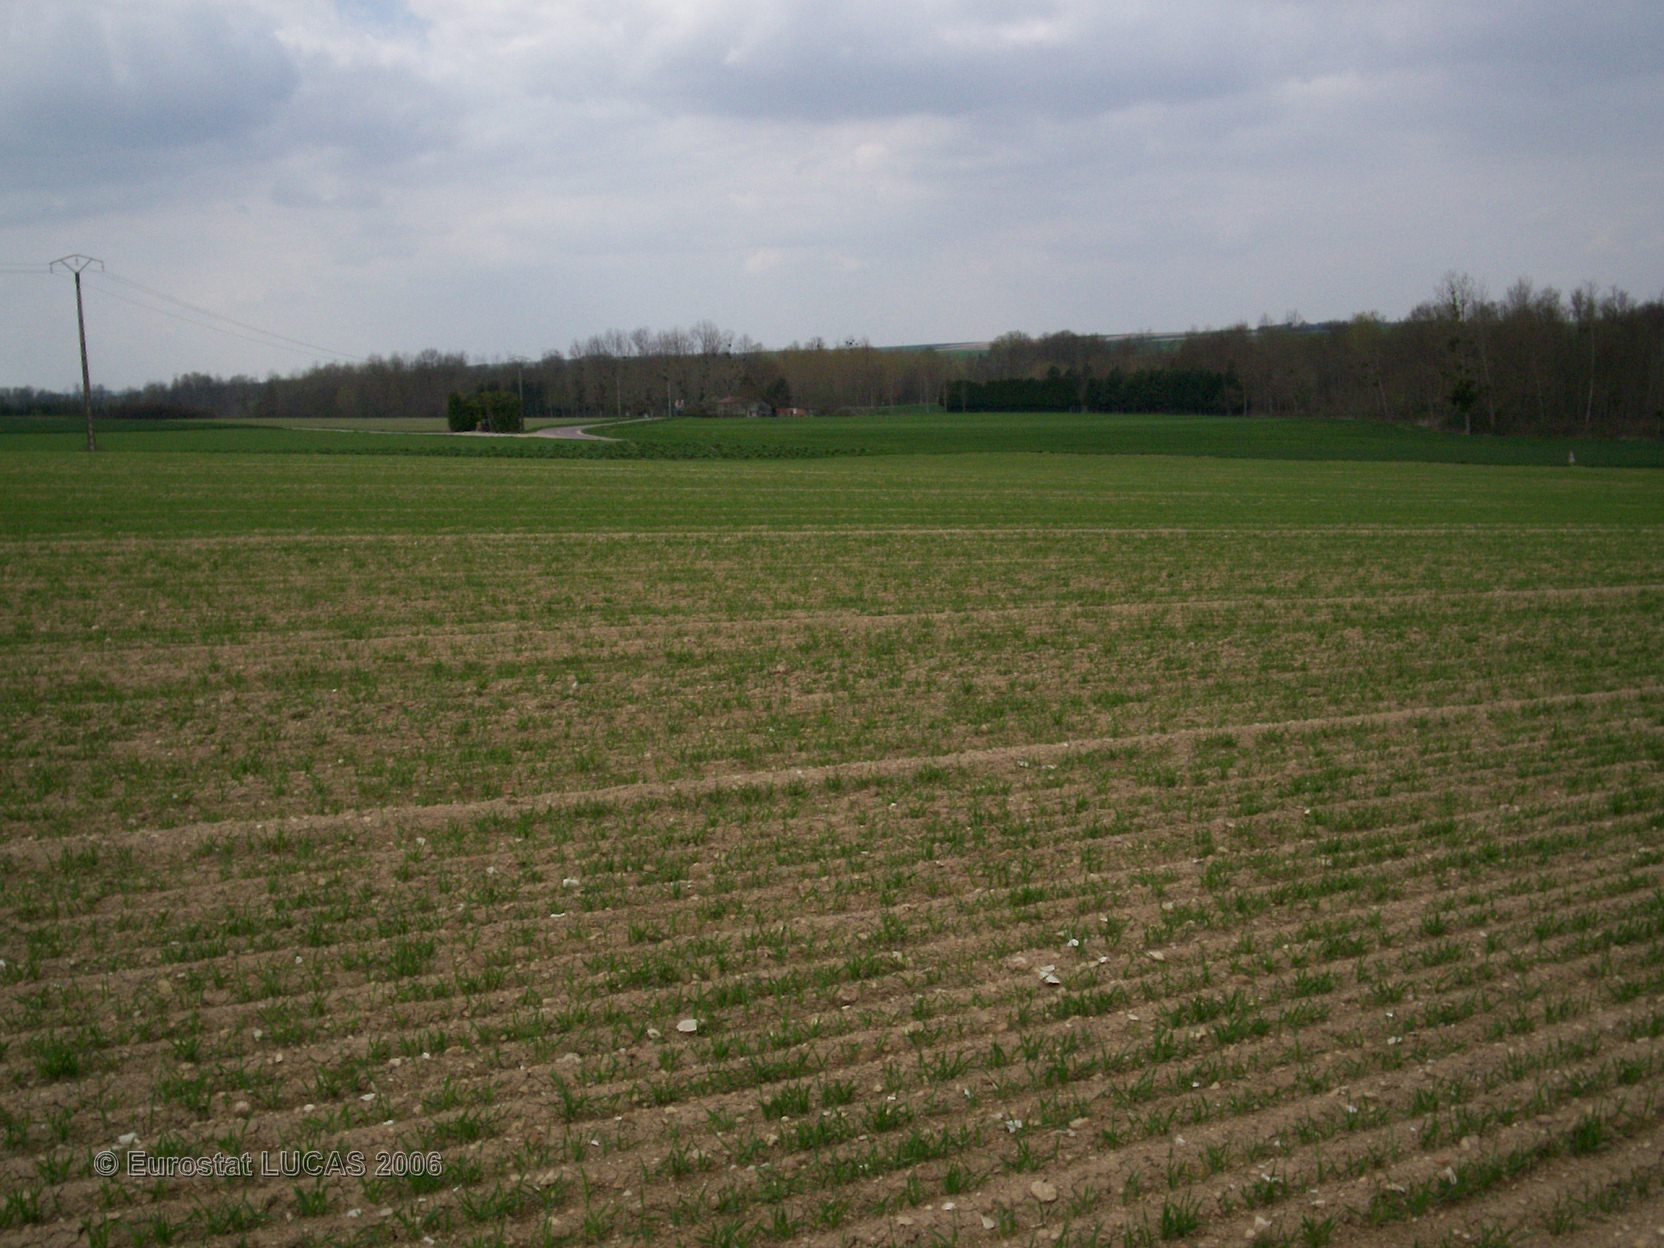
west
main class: Cropland
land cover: Barley
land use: Agriculture (excluding fallow land and kitchen gardens)
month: April
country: FR
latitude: 48.4813
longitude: 4.4639
